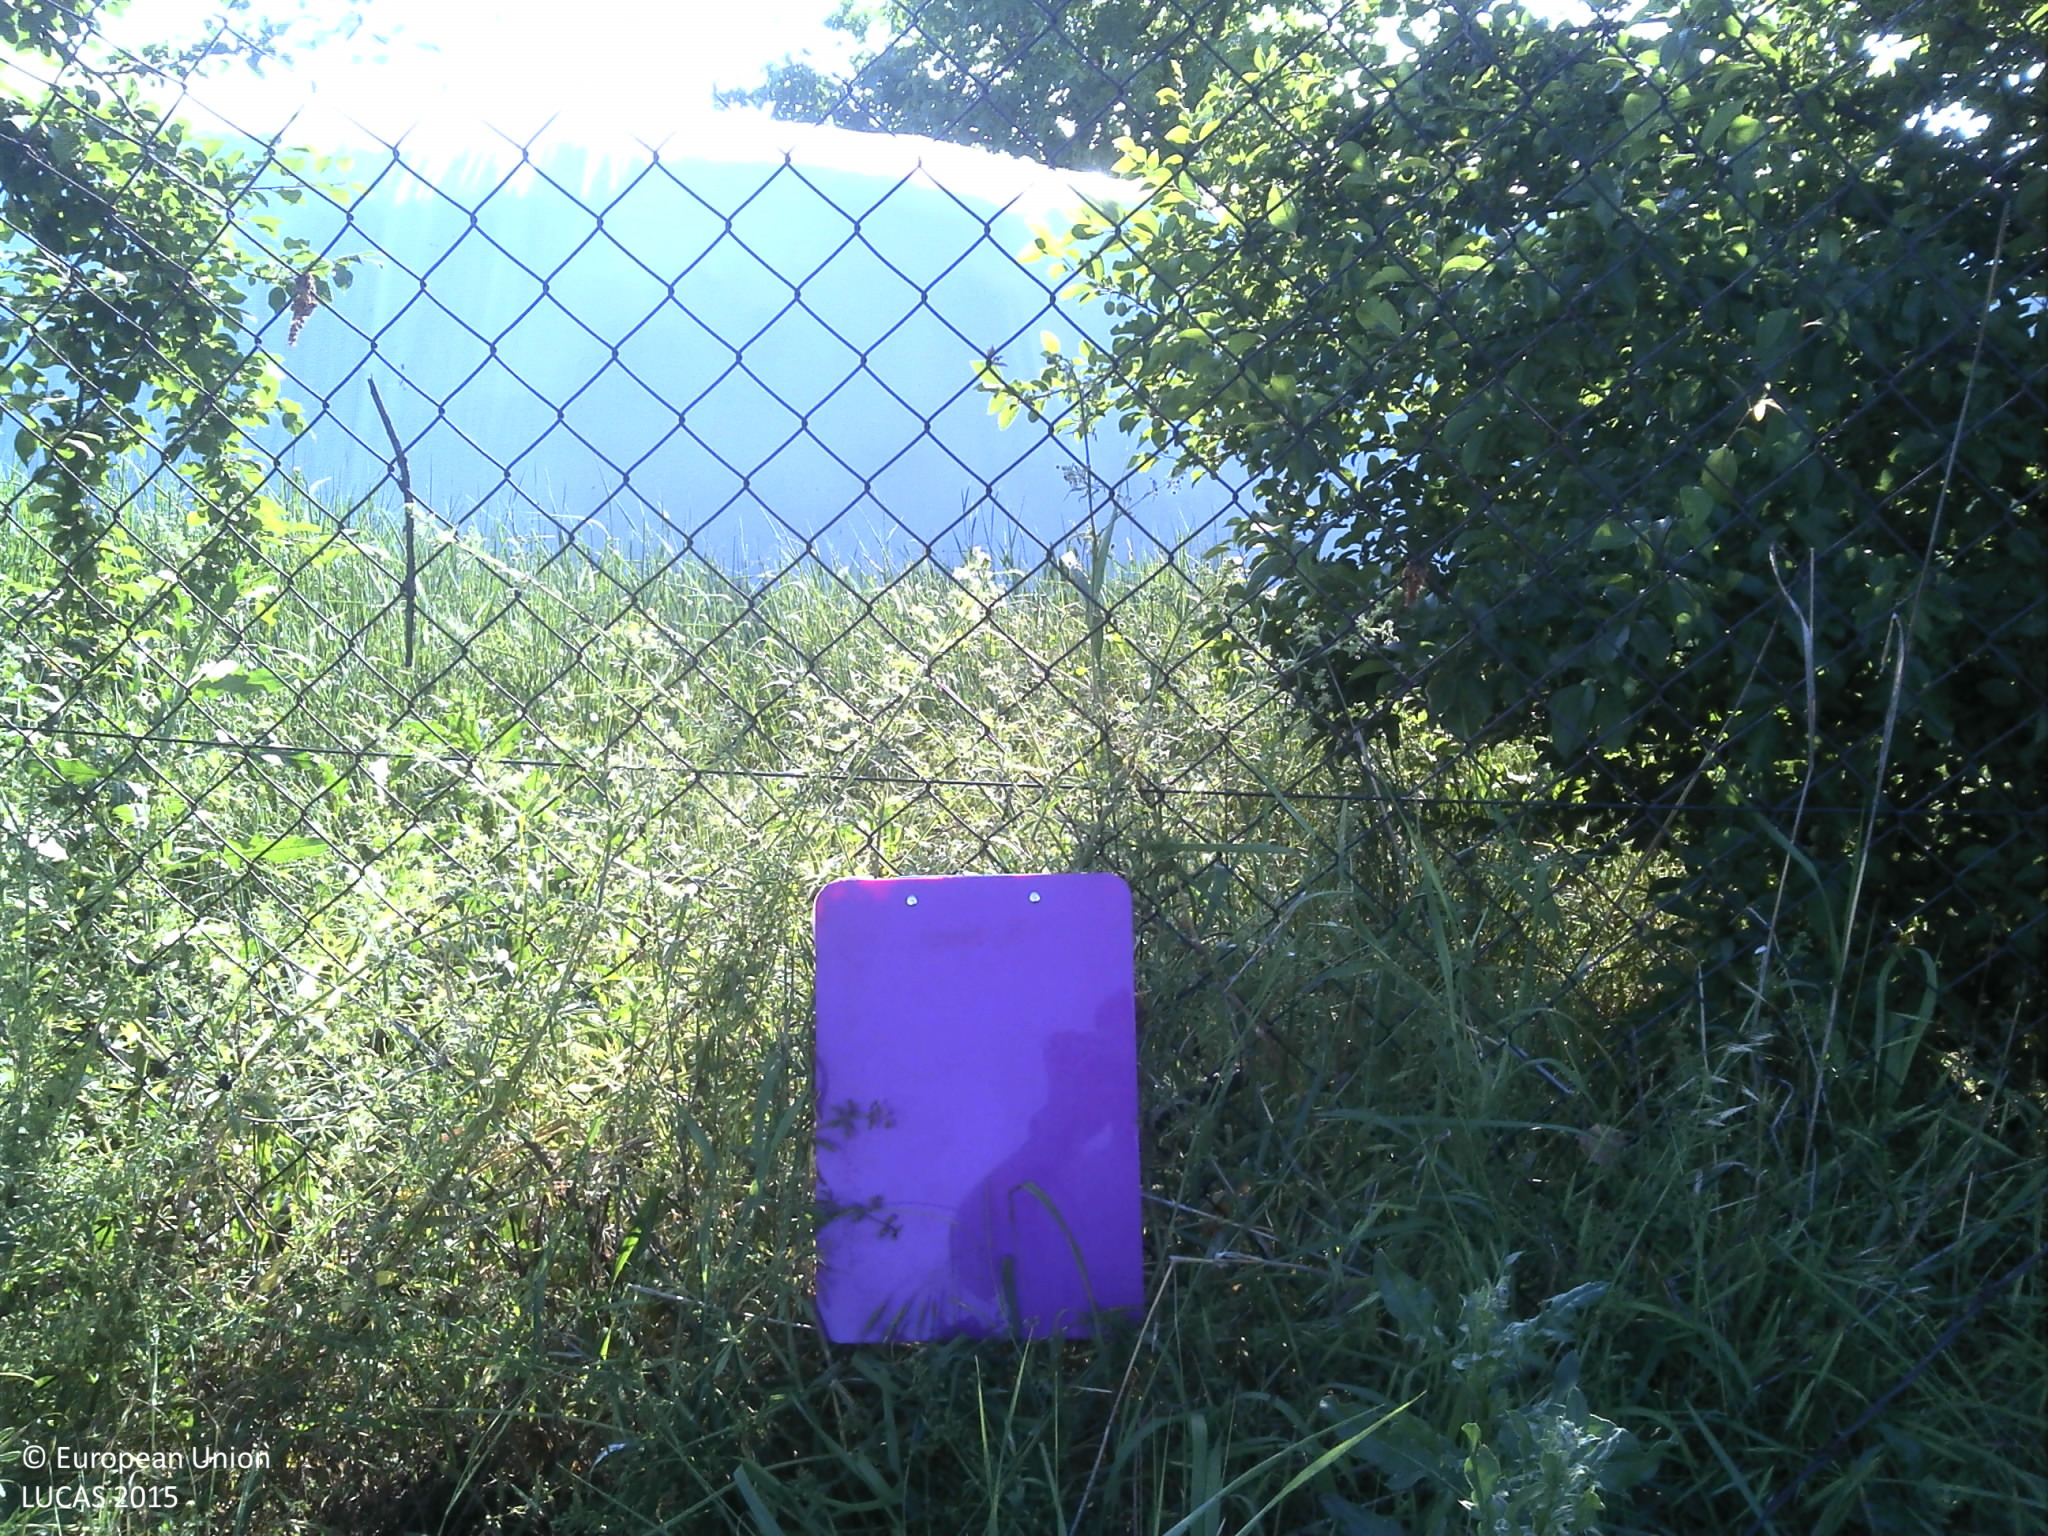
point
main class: Shrubland
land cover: Shrubland with sparse tree cover
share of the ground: > 75 %
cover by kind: shrubs 90 %, broadleaved forest trees 5 %, herbaceous plants 5 %
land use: Agriculture (excluding fallow land and kitchen gardens)
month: May
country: HR
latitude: 45.5293
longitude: 18.6503
